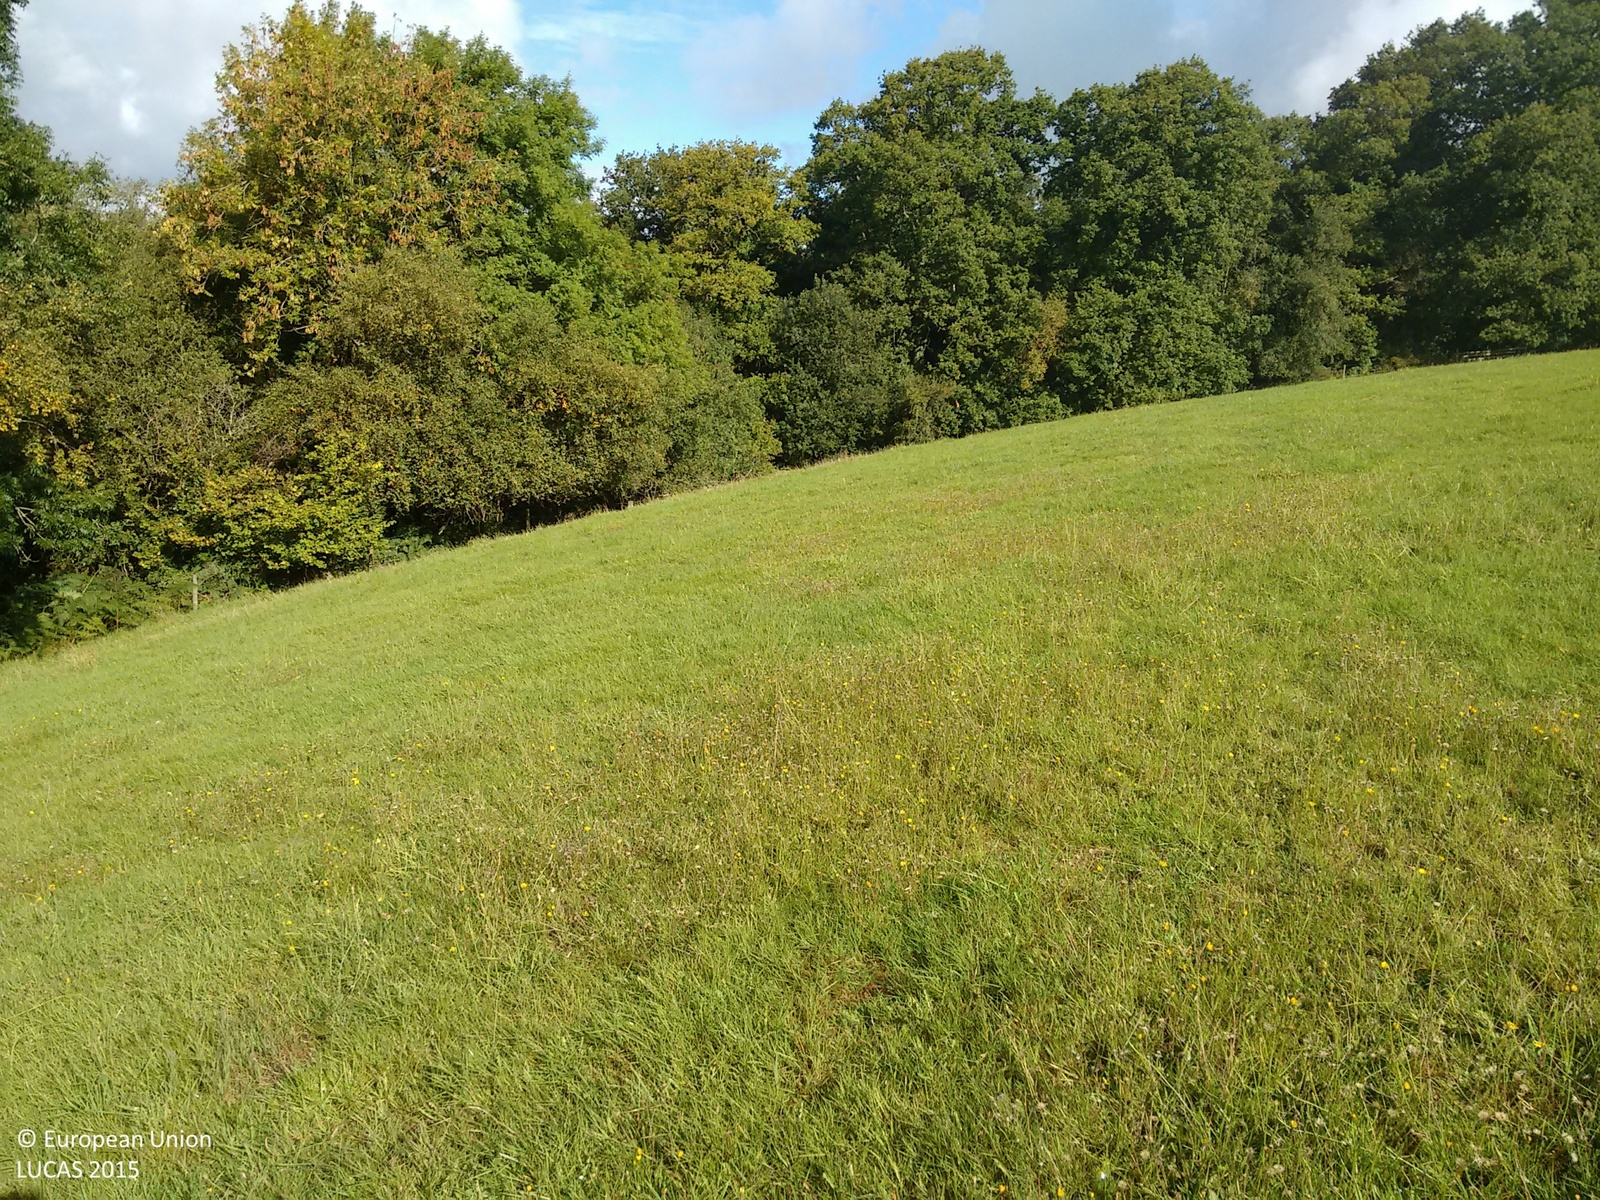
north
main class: Grassland
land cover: Grassland without tree/shrub cover
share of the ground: > 75 %
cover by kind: herbaceous plants 100 %
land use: Agriculture (excluding fallow land and kitchen gardens)
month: September
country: GB
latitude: 50.7390
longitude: -3.8501
